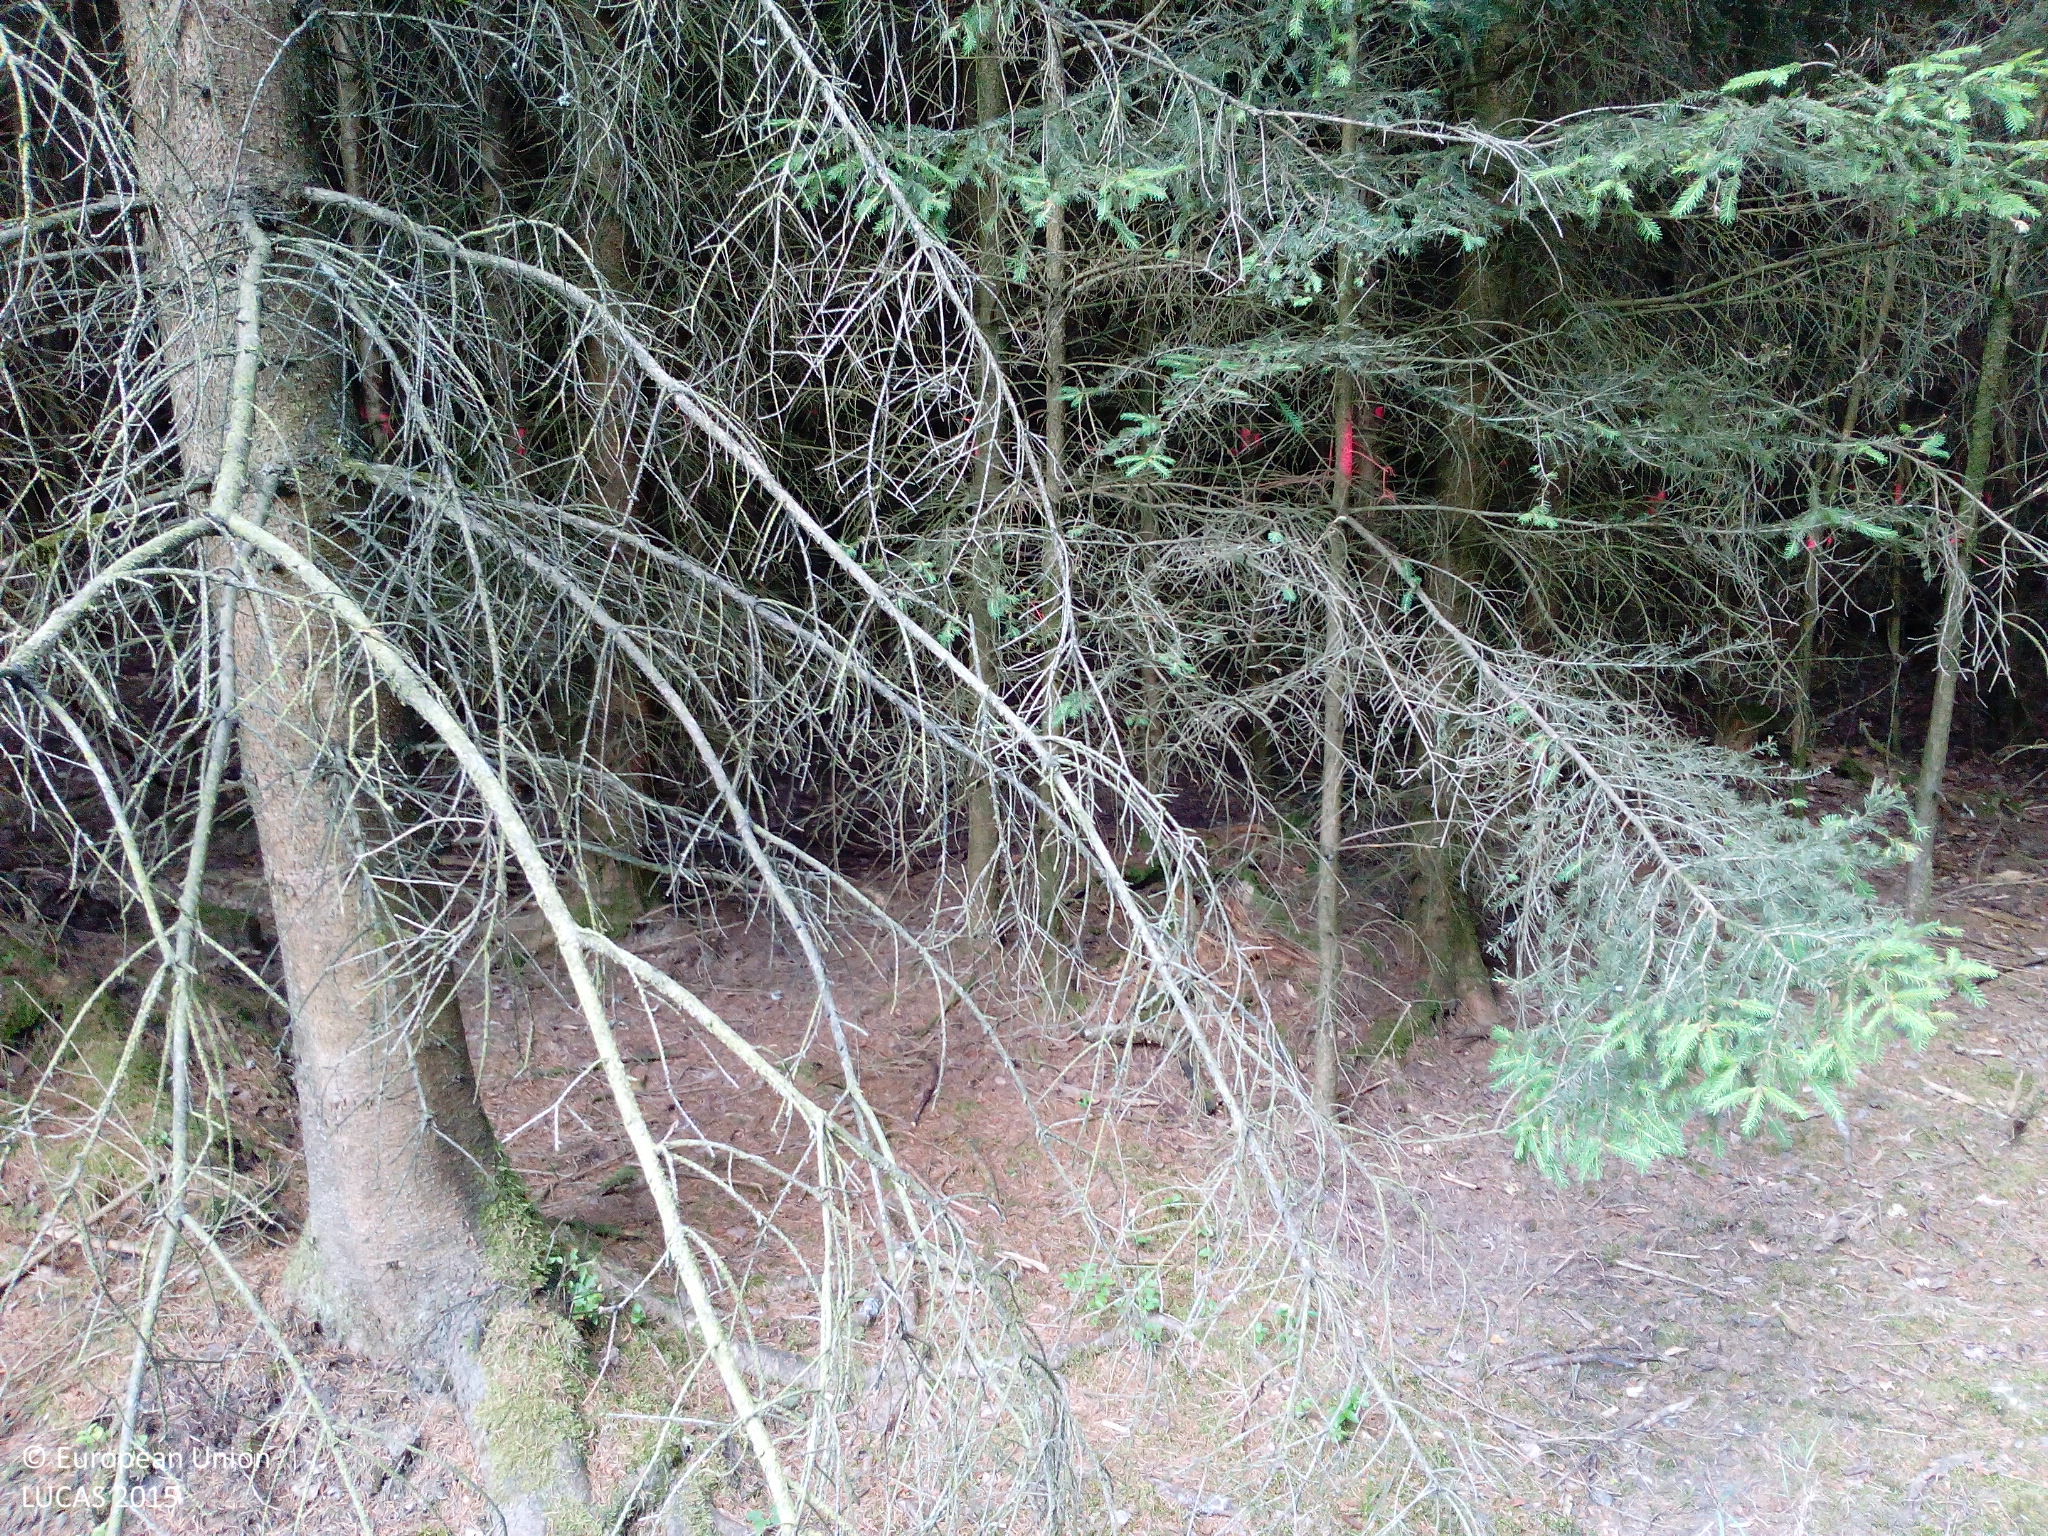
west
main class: Woodland
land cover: Spruce dominated coniferous woodland
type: hemiboreal forest and nemoral coniferous forest and mixed broadleaved-coniferous forest
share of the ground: > 75 %
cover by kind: coniferous forest trees 95 %, consolidated bare surface 5 %
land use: Forestry
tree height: > 5 m
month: July
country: DE
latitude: 48.9057
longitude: 12.0867
